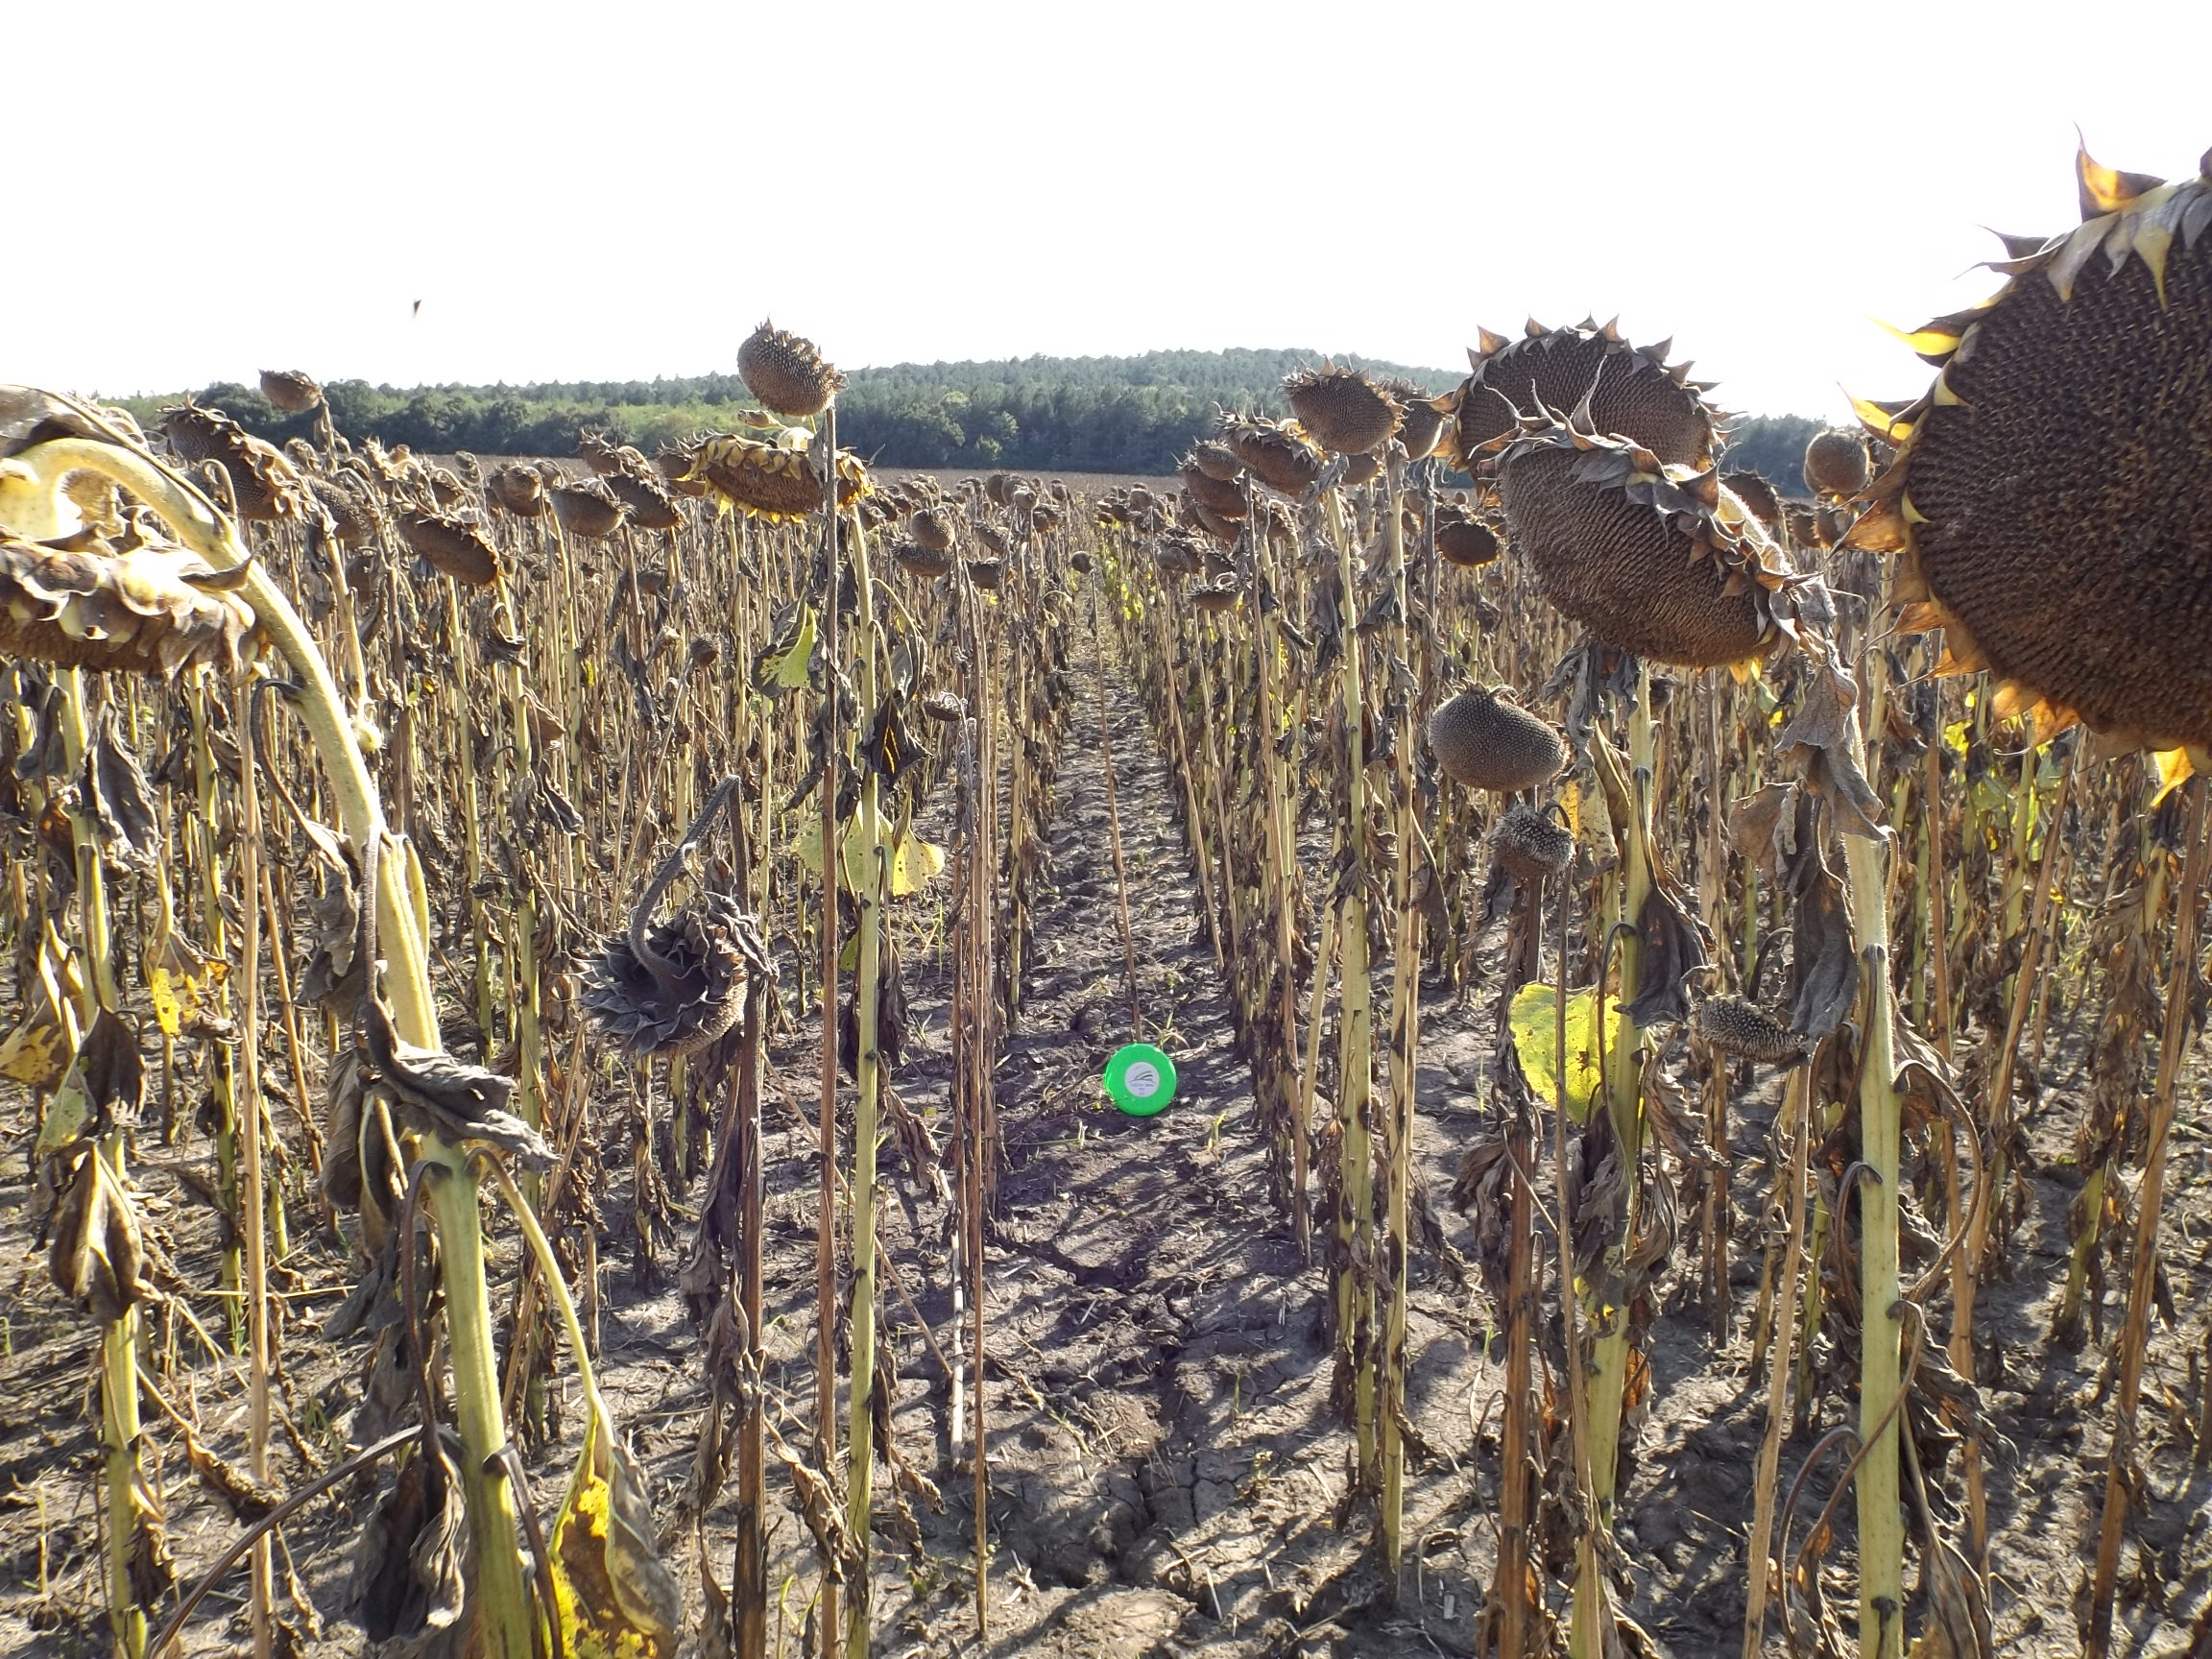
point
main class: Cropland
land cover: Sunflower
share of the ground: > 75 %
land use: Agriculture (excluding fallow land and kitchen gardens)
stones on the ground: < 10 %
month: August
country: BG
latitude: 43.1040
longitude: 27.4120
